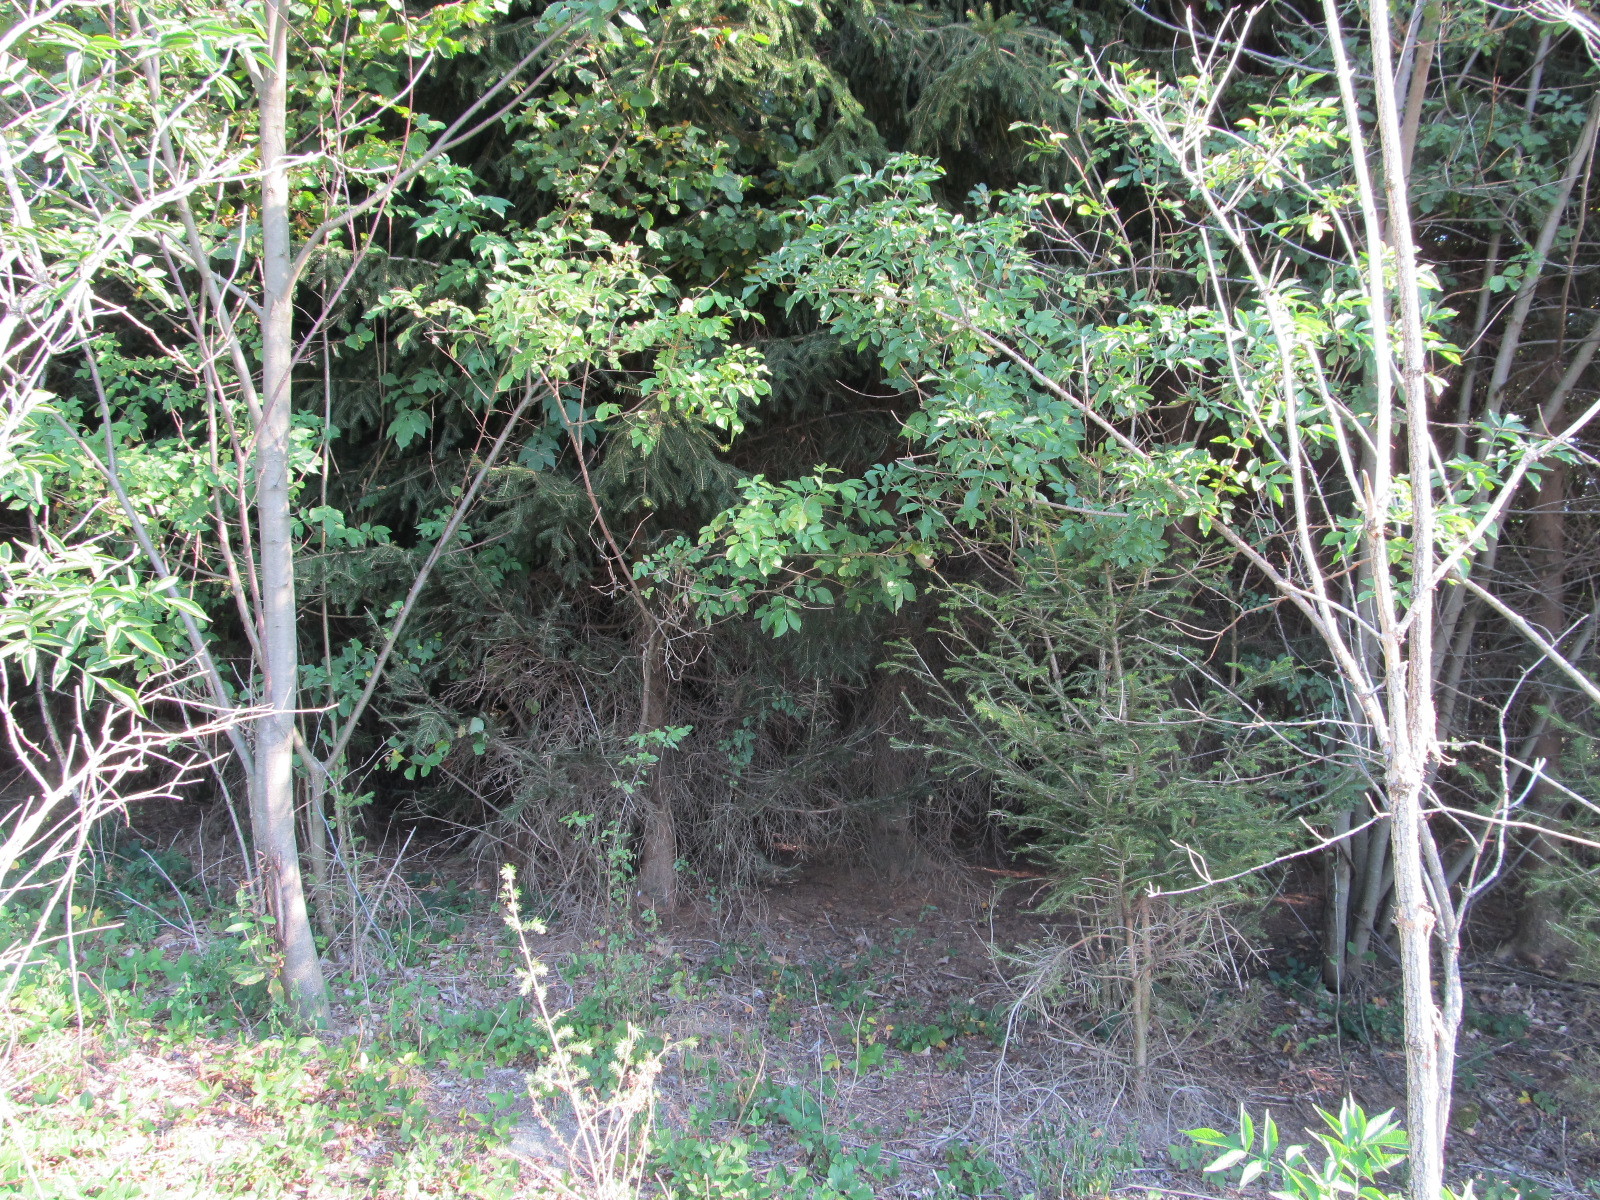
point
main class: Woodland
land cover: Spruce dominated coniferous woodland
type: hemiboreal forest and nemoral coniferous forest and mixed broadleaved-coniferous forest
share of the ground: > 75 %
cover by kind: coniferous forest trees 100 %
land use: Forestry
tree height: > 5 m
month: August
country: AT
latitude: 48.0893
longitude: 15.4394
